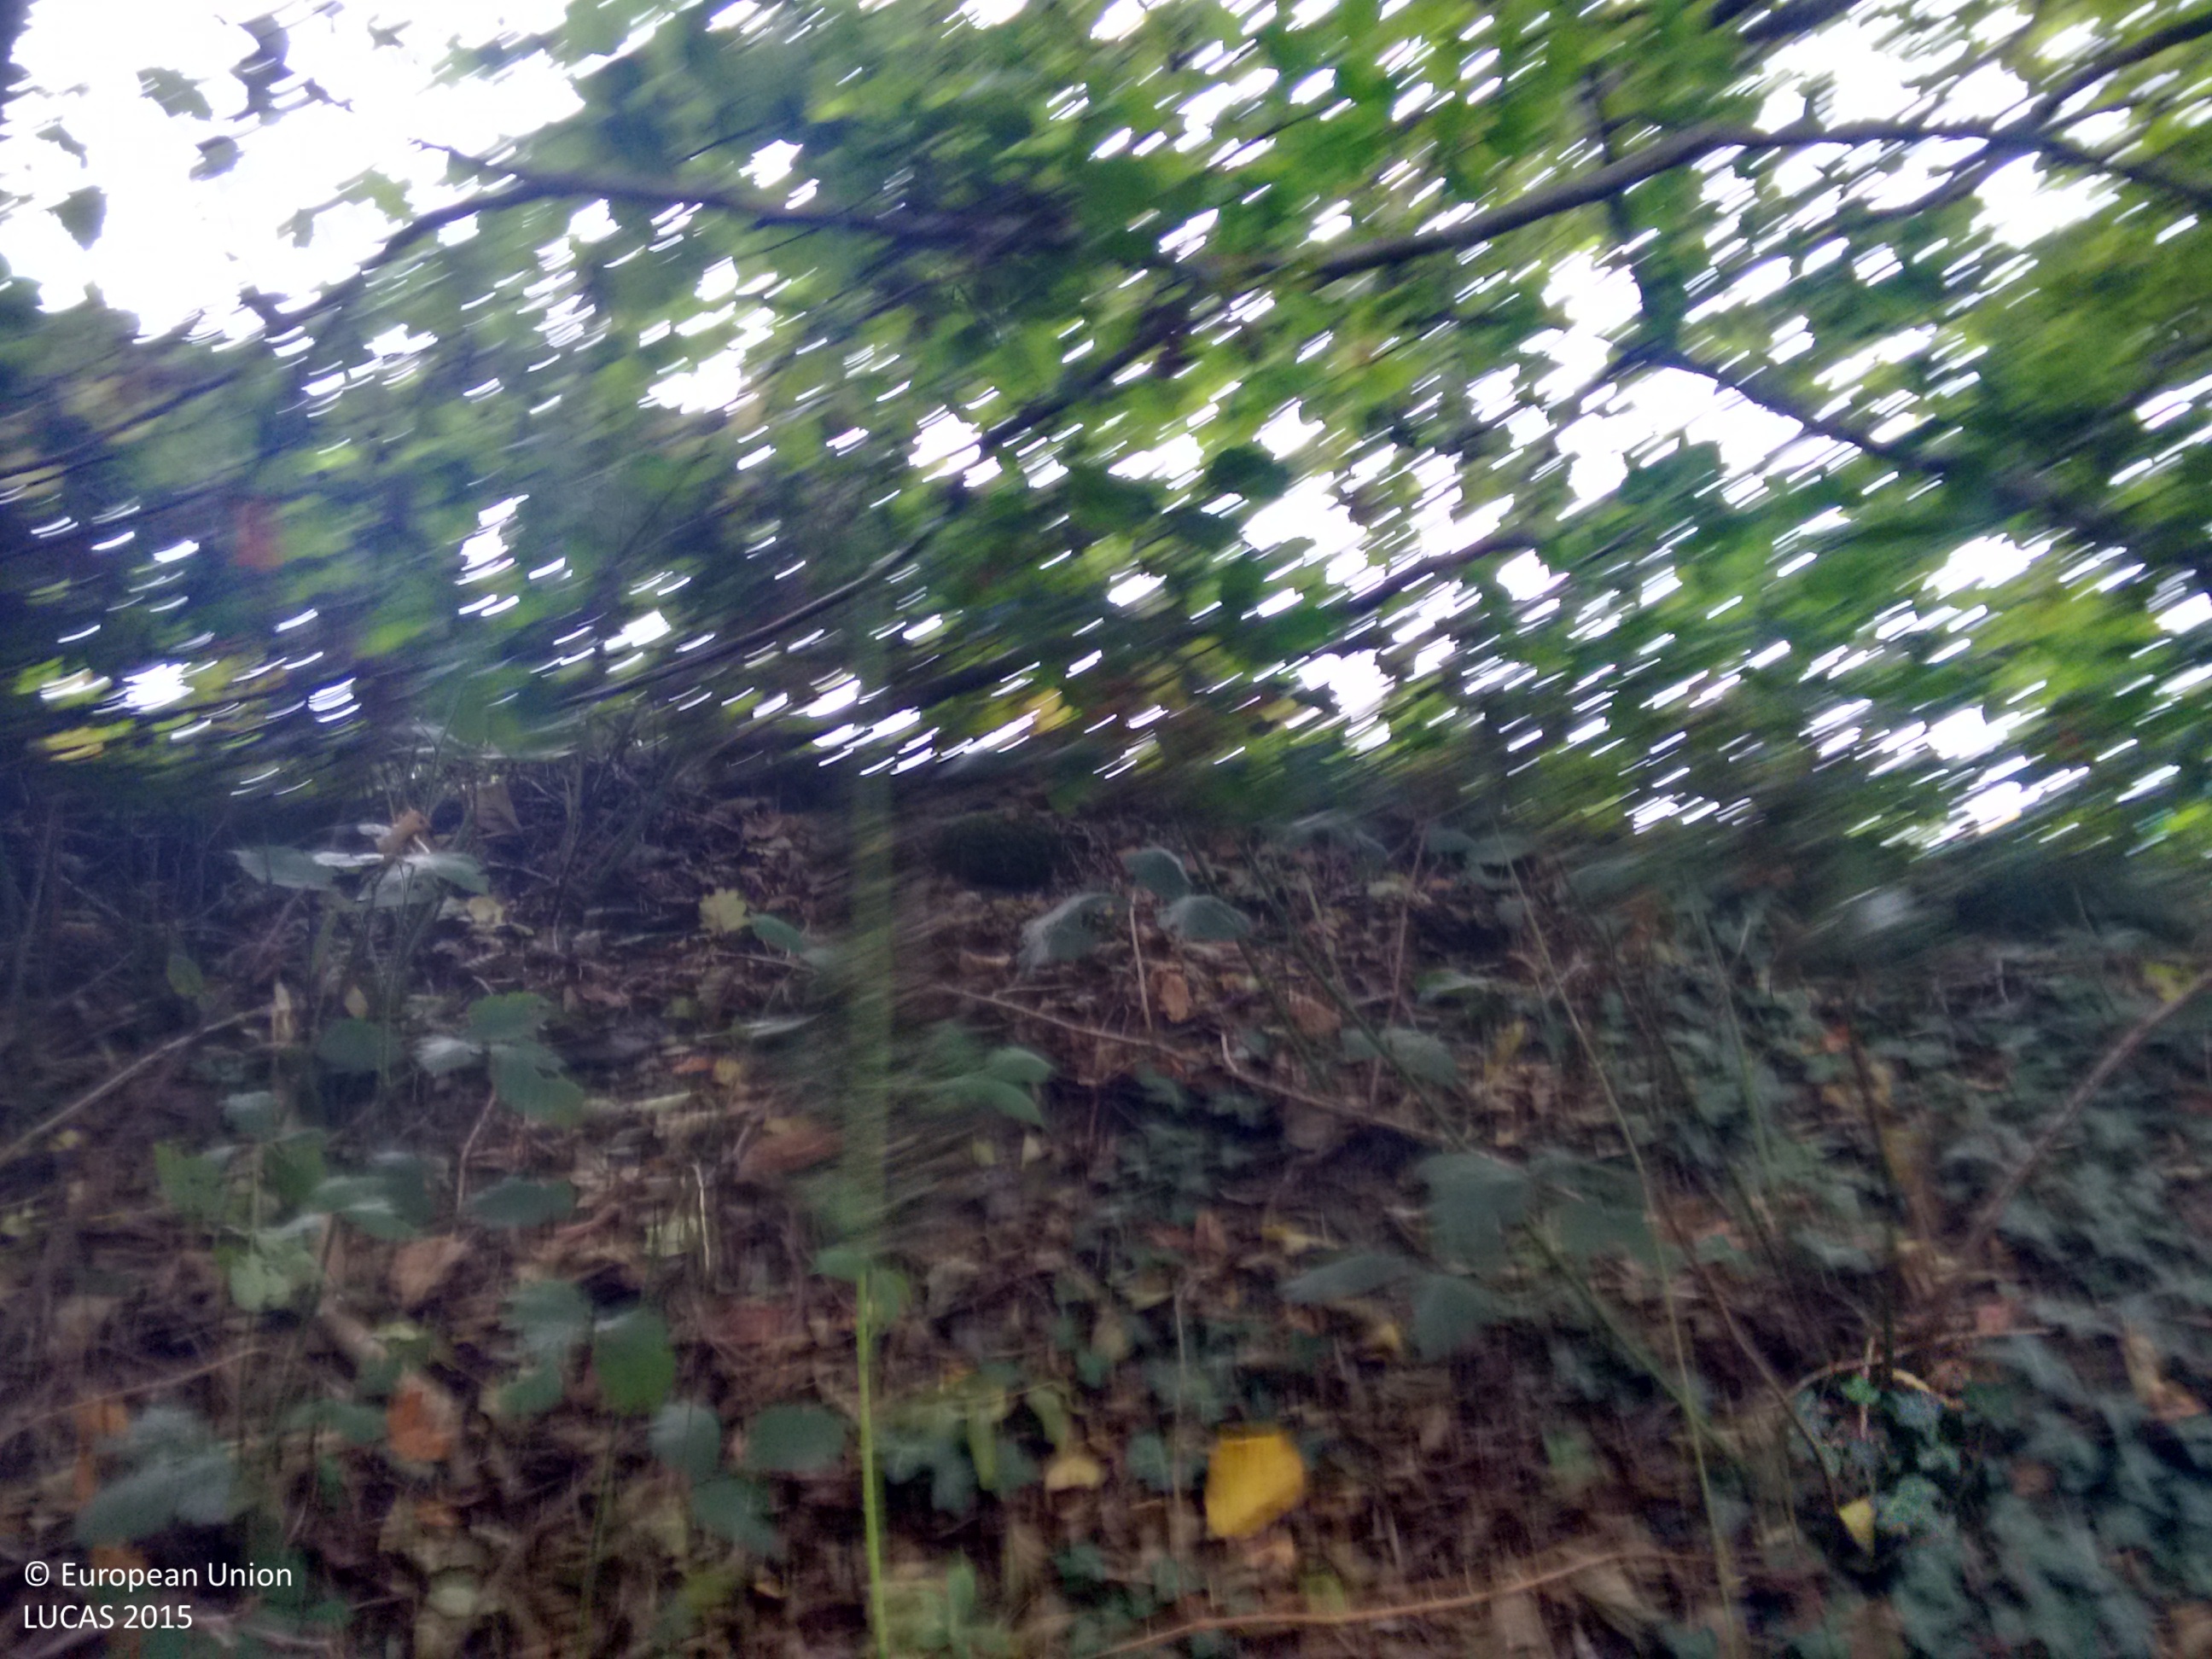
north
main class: Woodland
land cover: Broadleaved woodland
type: mesophytic deciduous forest
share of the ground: > 75 %
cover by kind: broadleaved forest trees 100 %
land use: Semi-natural and natural areas not in use
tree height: > 5 m
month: October
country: GB
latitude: 52.4376
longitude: -3.9953
